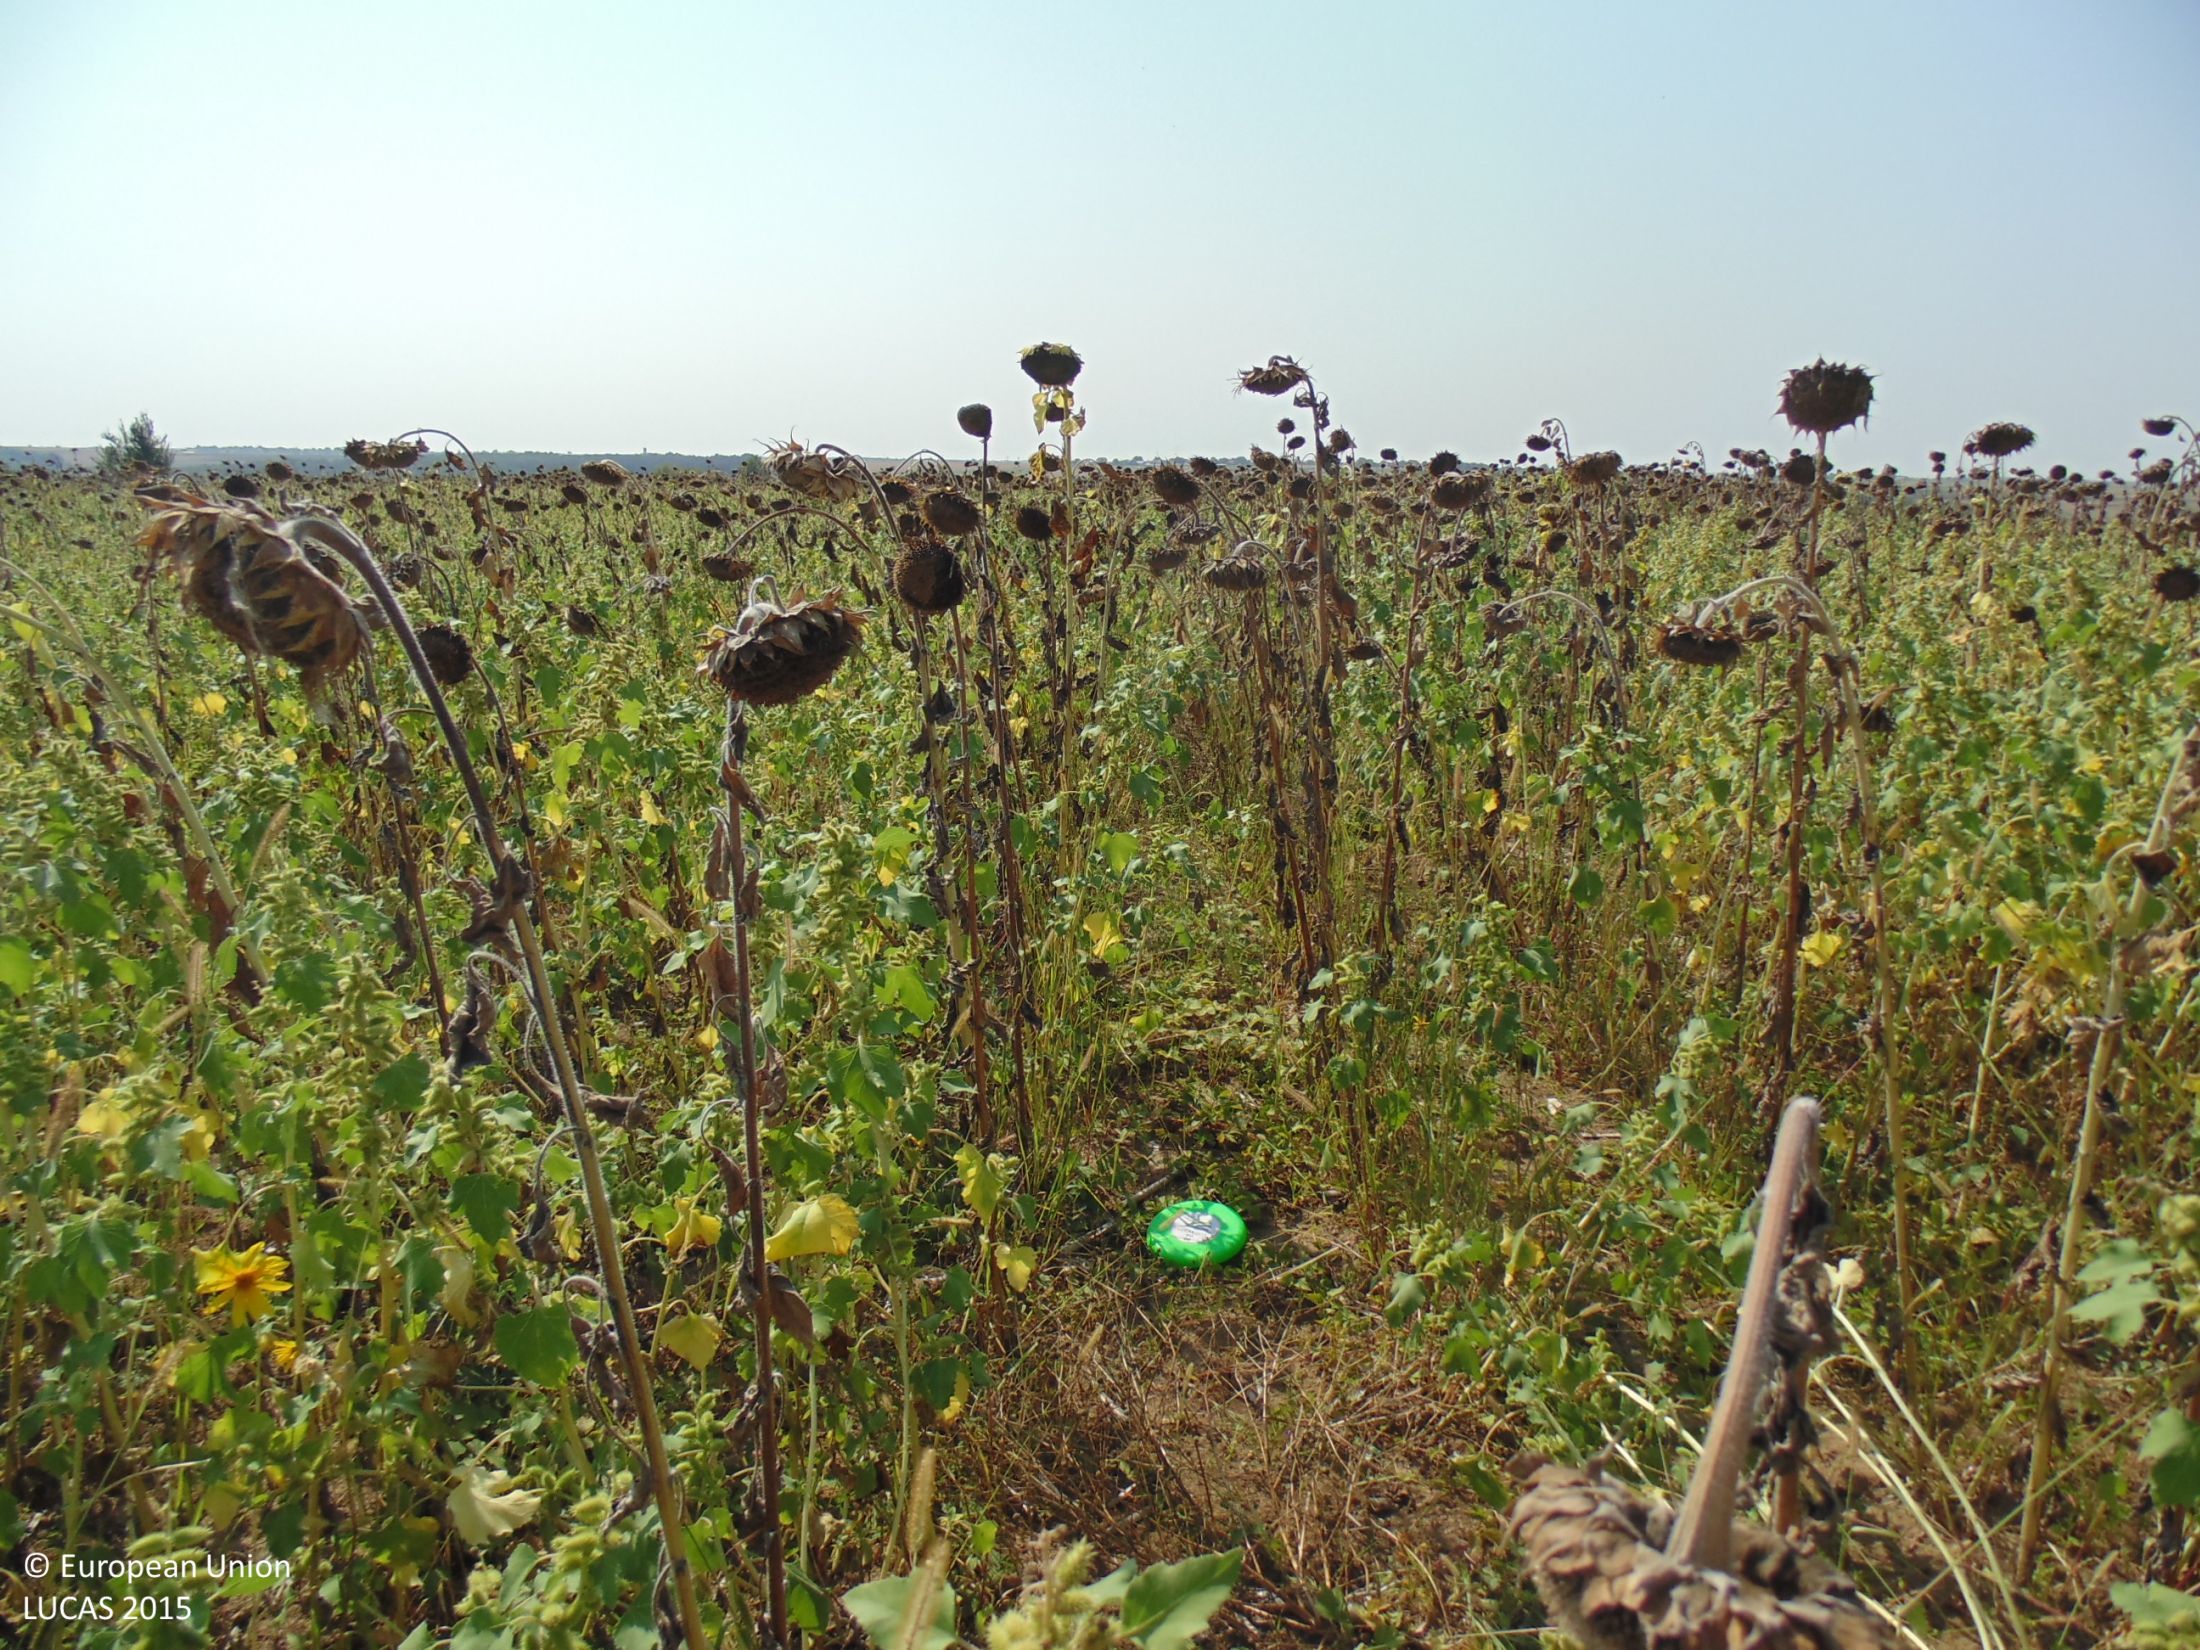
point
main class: Cropland
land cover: Sunflower
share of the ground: > 75 %
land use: Agriculture (excluding fallow land and kitchen gardens)
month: September
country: BG
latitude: 43.8319
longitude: 26.9200
